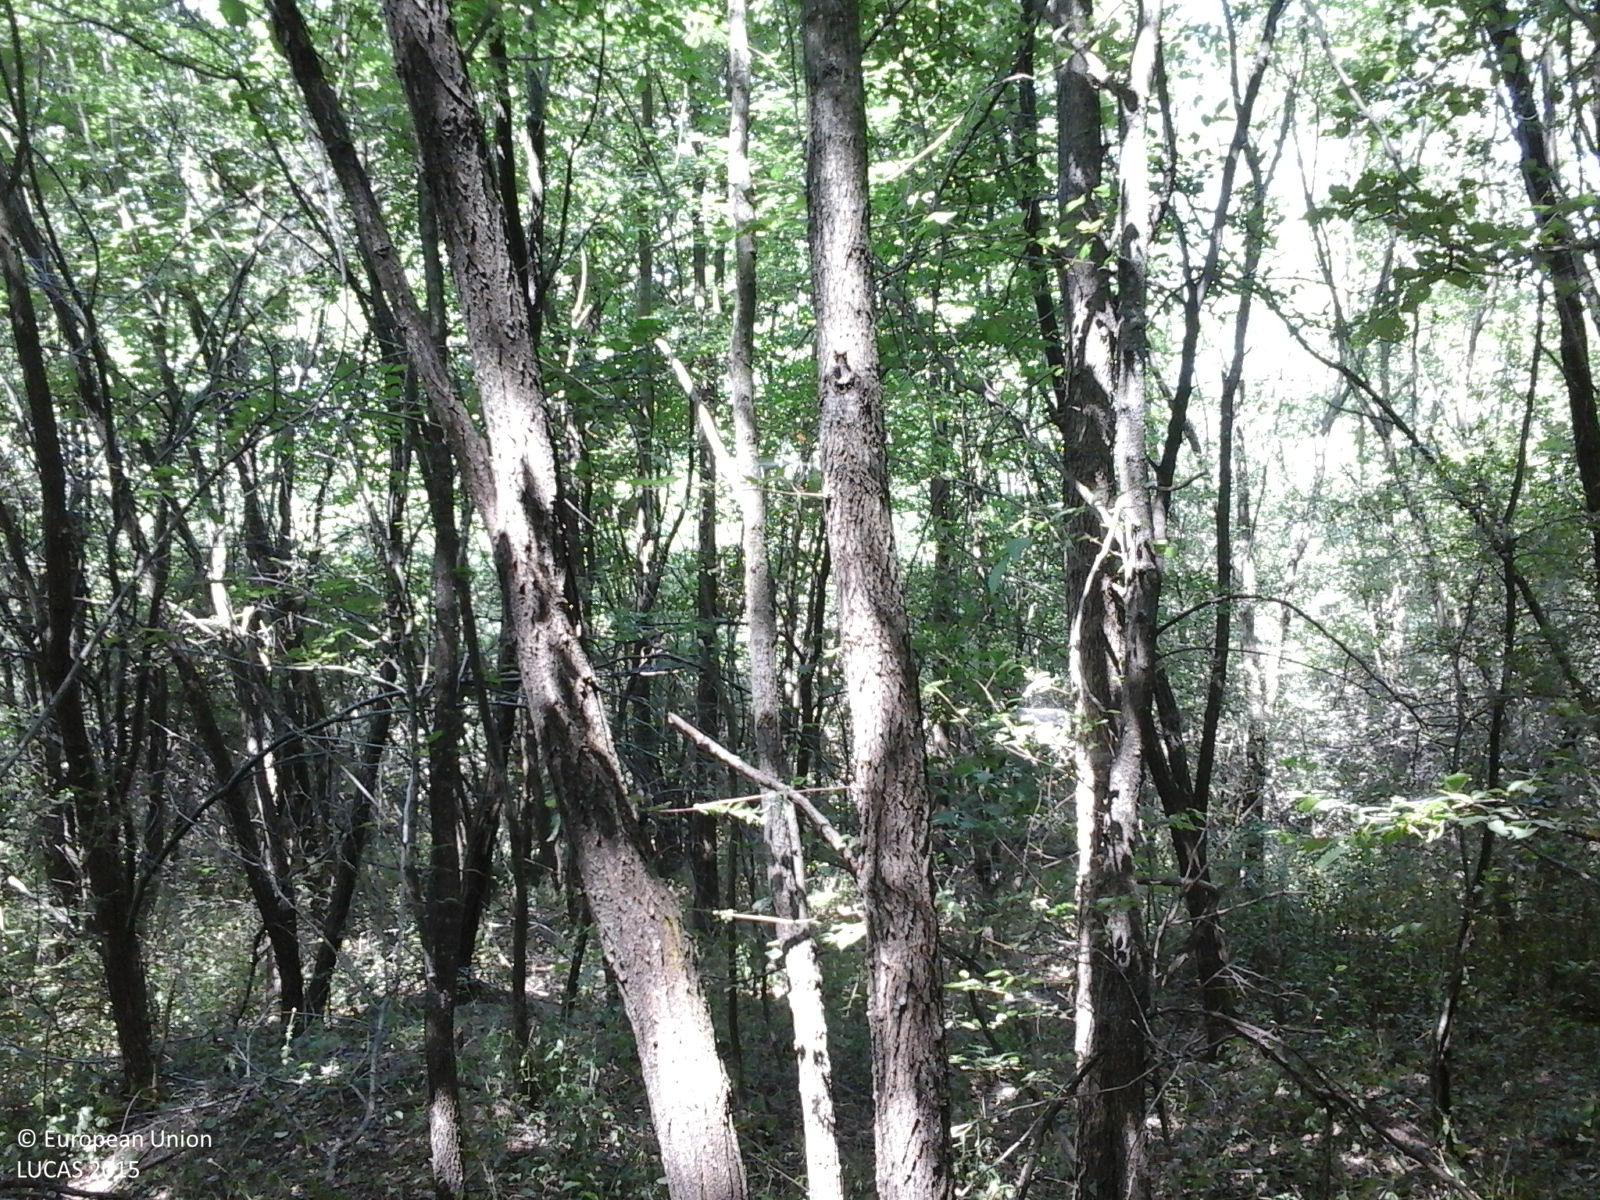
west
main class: Woodland
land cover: Broadleaved woodland
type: non-riverine alder, birch or aspen forest
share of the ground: > 75 %
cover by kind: broadleaved forest trees 100 %
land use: Forestry
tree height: > 5 m
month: July
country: RO
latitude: 44.6811
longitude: 24.6214
